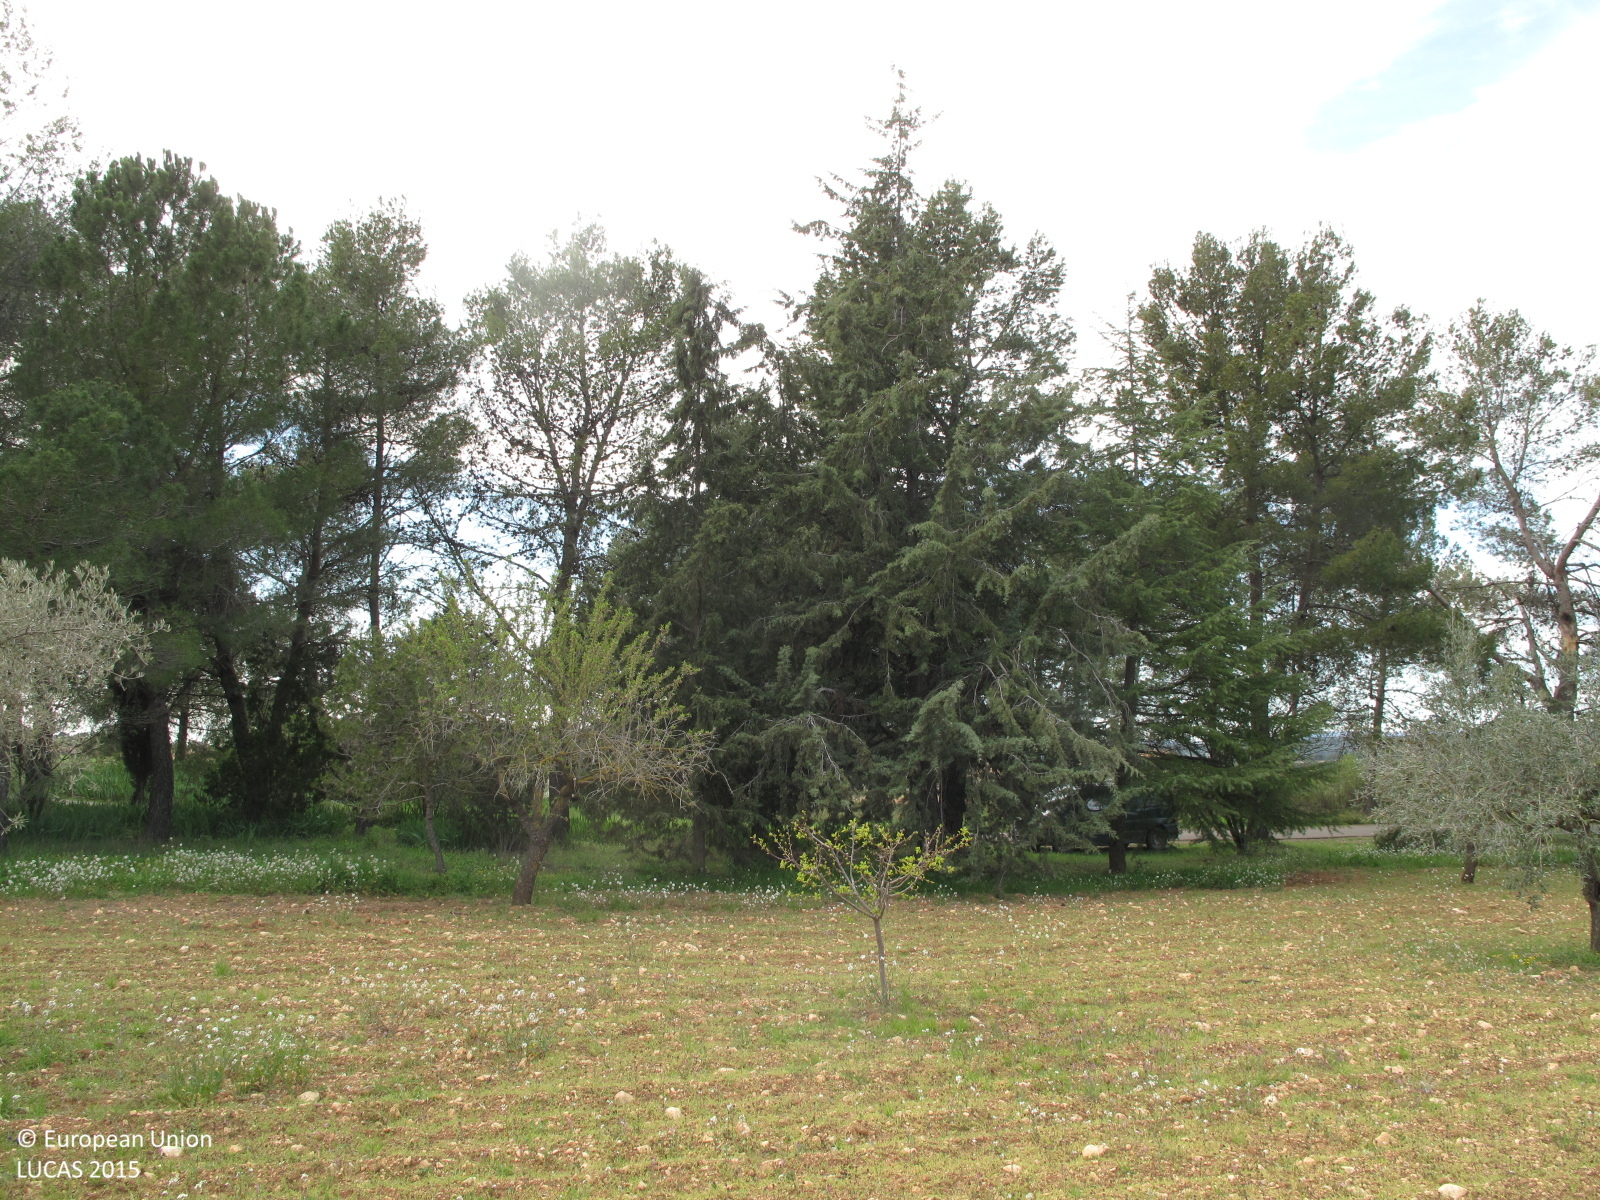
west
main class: Cropland
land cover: Cherry fruit
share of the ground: 10 - 25 %
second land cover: Other fruit trees and berries
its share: < 10 %
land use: Agriculture (excluding fallow land and kitchen gardens)
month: March
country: ES
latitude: 38.7802
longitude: -0.7544
